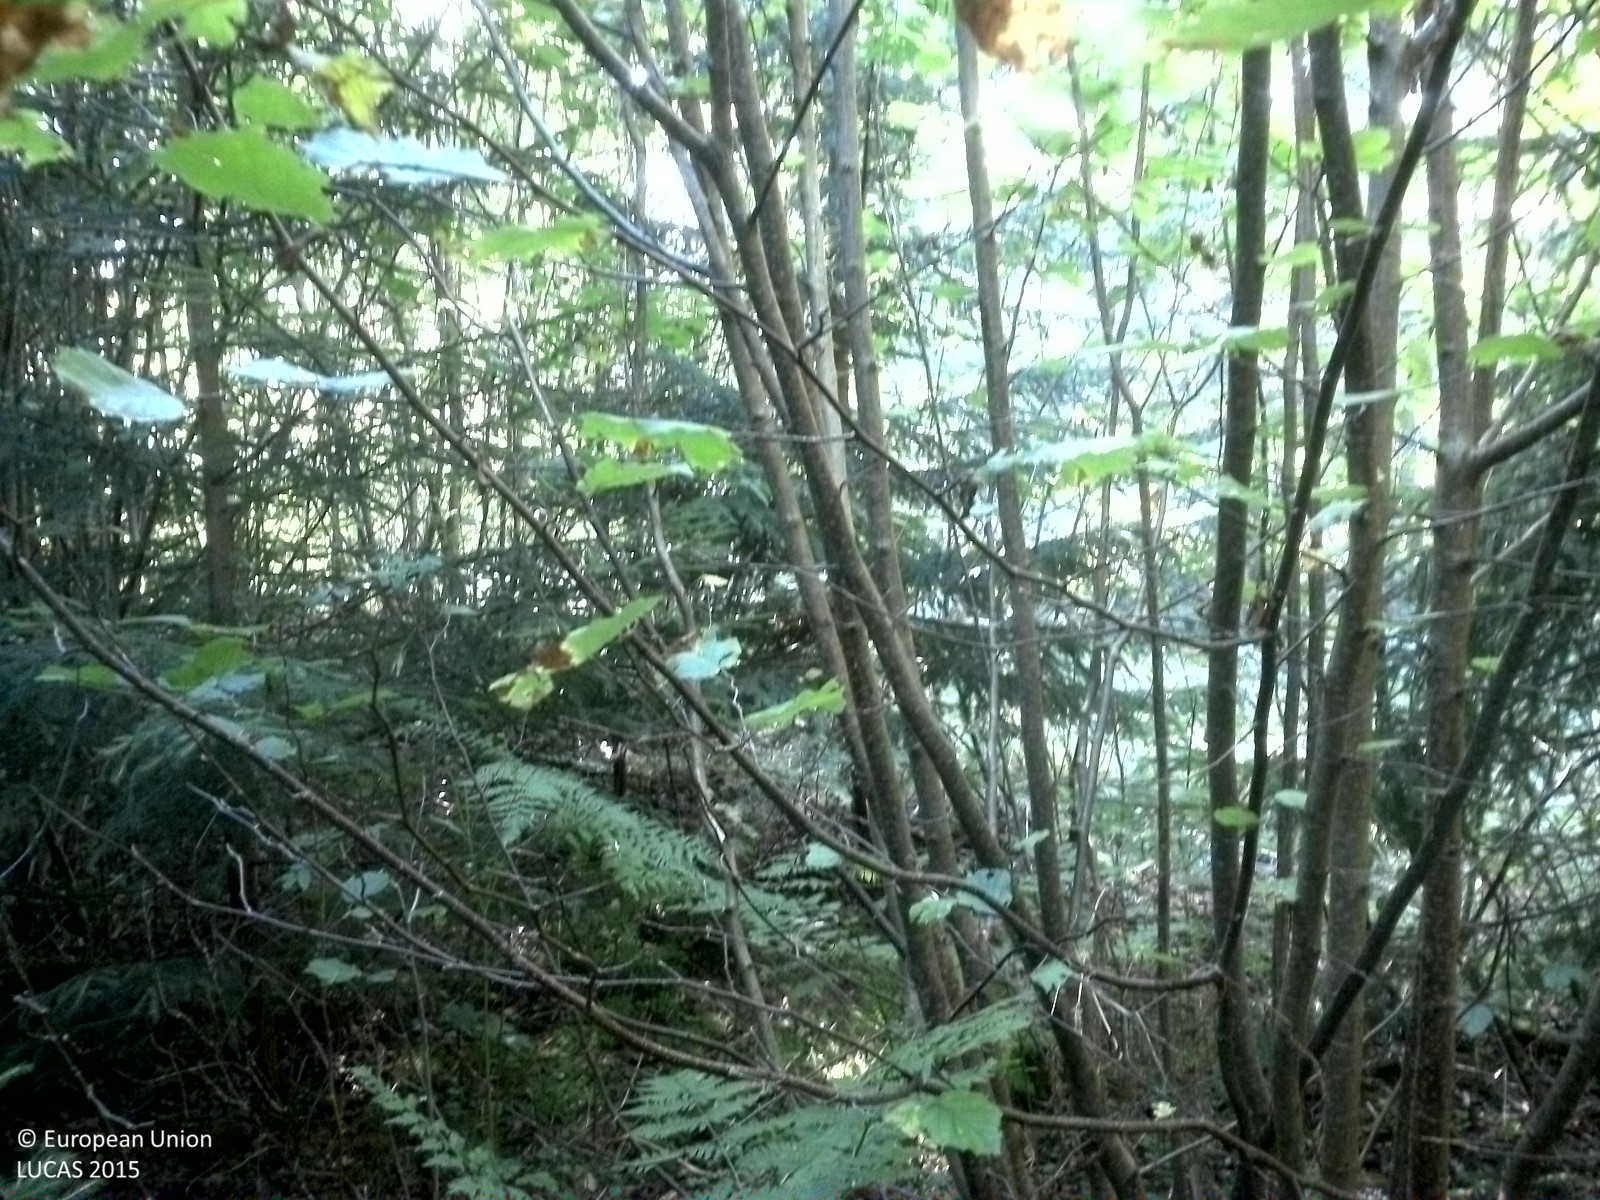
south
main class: Woodland
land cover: Spruce dominated mixed woodland
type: boreal forest
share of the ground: > 75 %
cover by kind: coniferous forest trees 50 %, broadleaved forest trees 30 %, lichens and mosses 10 %, herbaceous plants 5 %, unconsolidated bare surface 5 %
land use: Forestry
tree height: < 5 m
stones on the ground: < 10 %
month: August
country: SE
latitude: 58.6503
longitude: 14.9736
